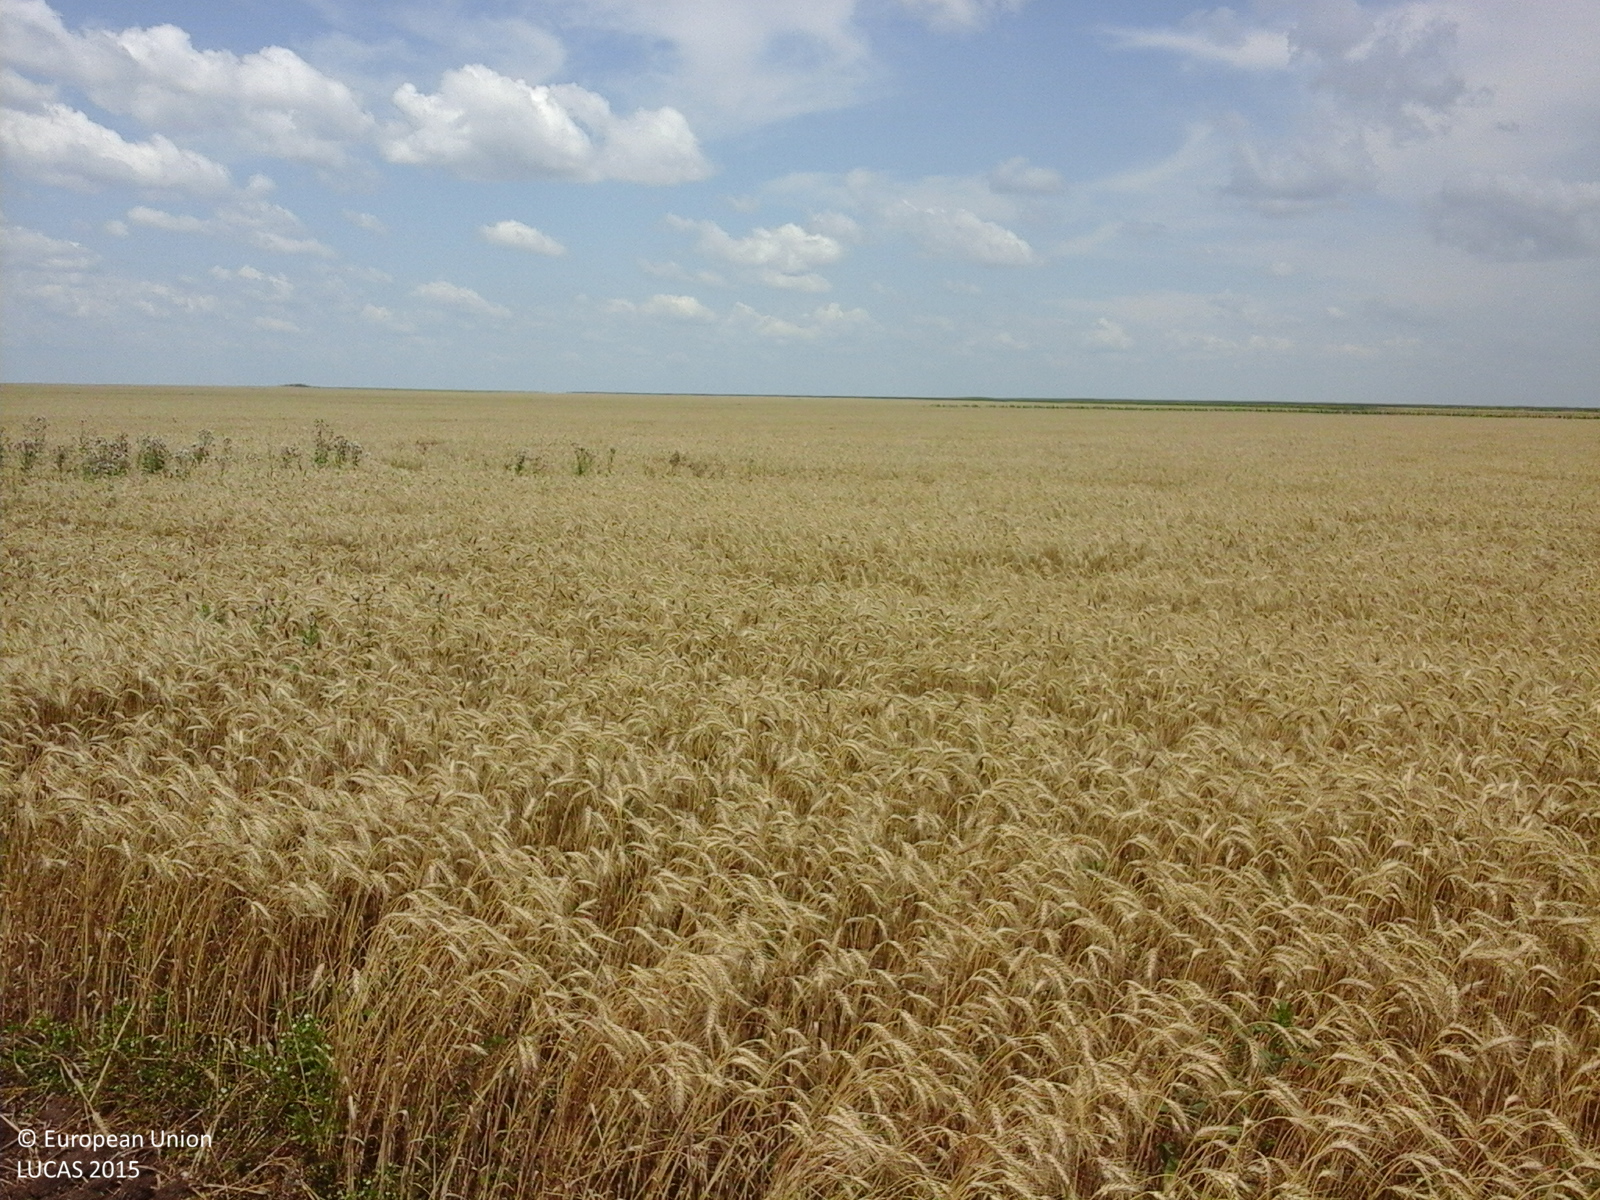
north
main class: Cropland
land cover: Common wheat
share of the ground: > 75 %
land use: Agriculture (excluding fallow land and kitchen gardens)
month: July
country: RO
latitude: 43.8937
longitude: 24.3665
